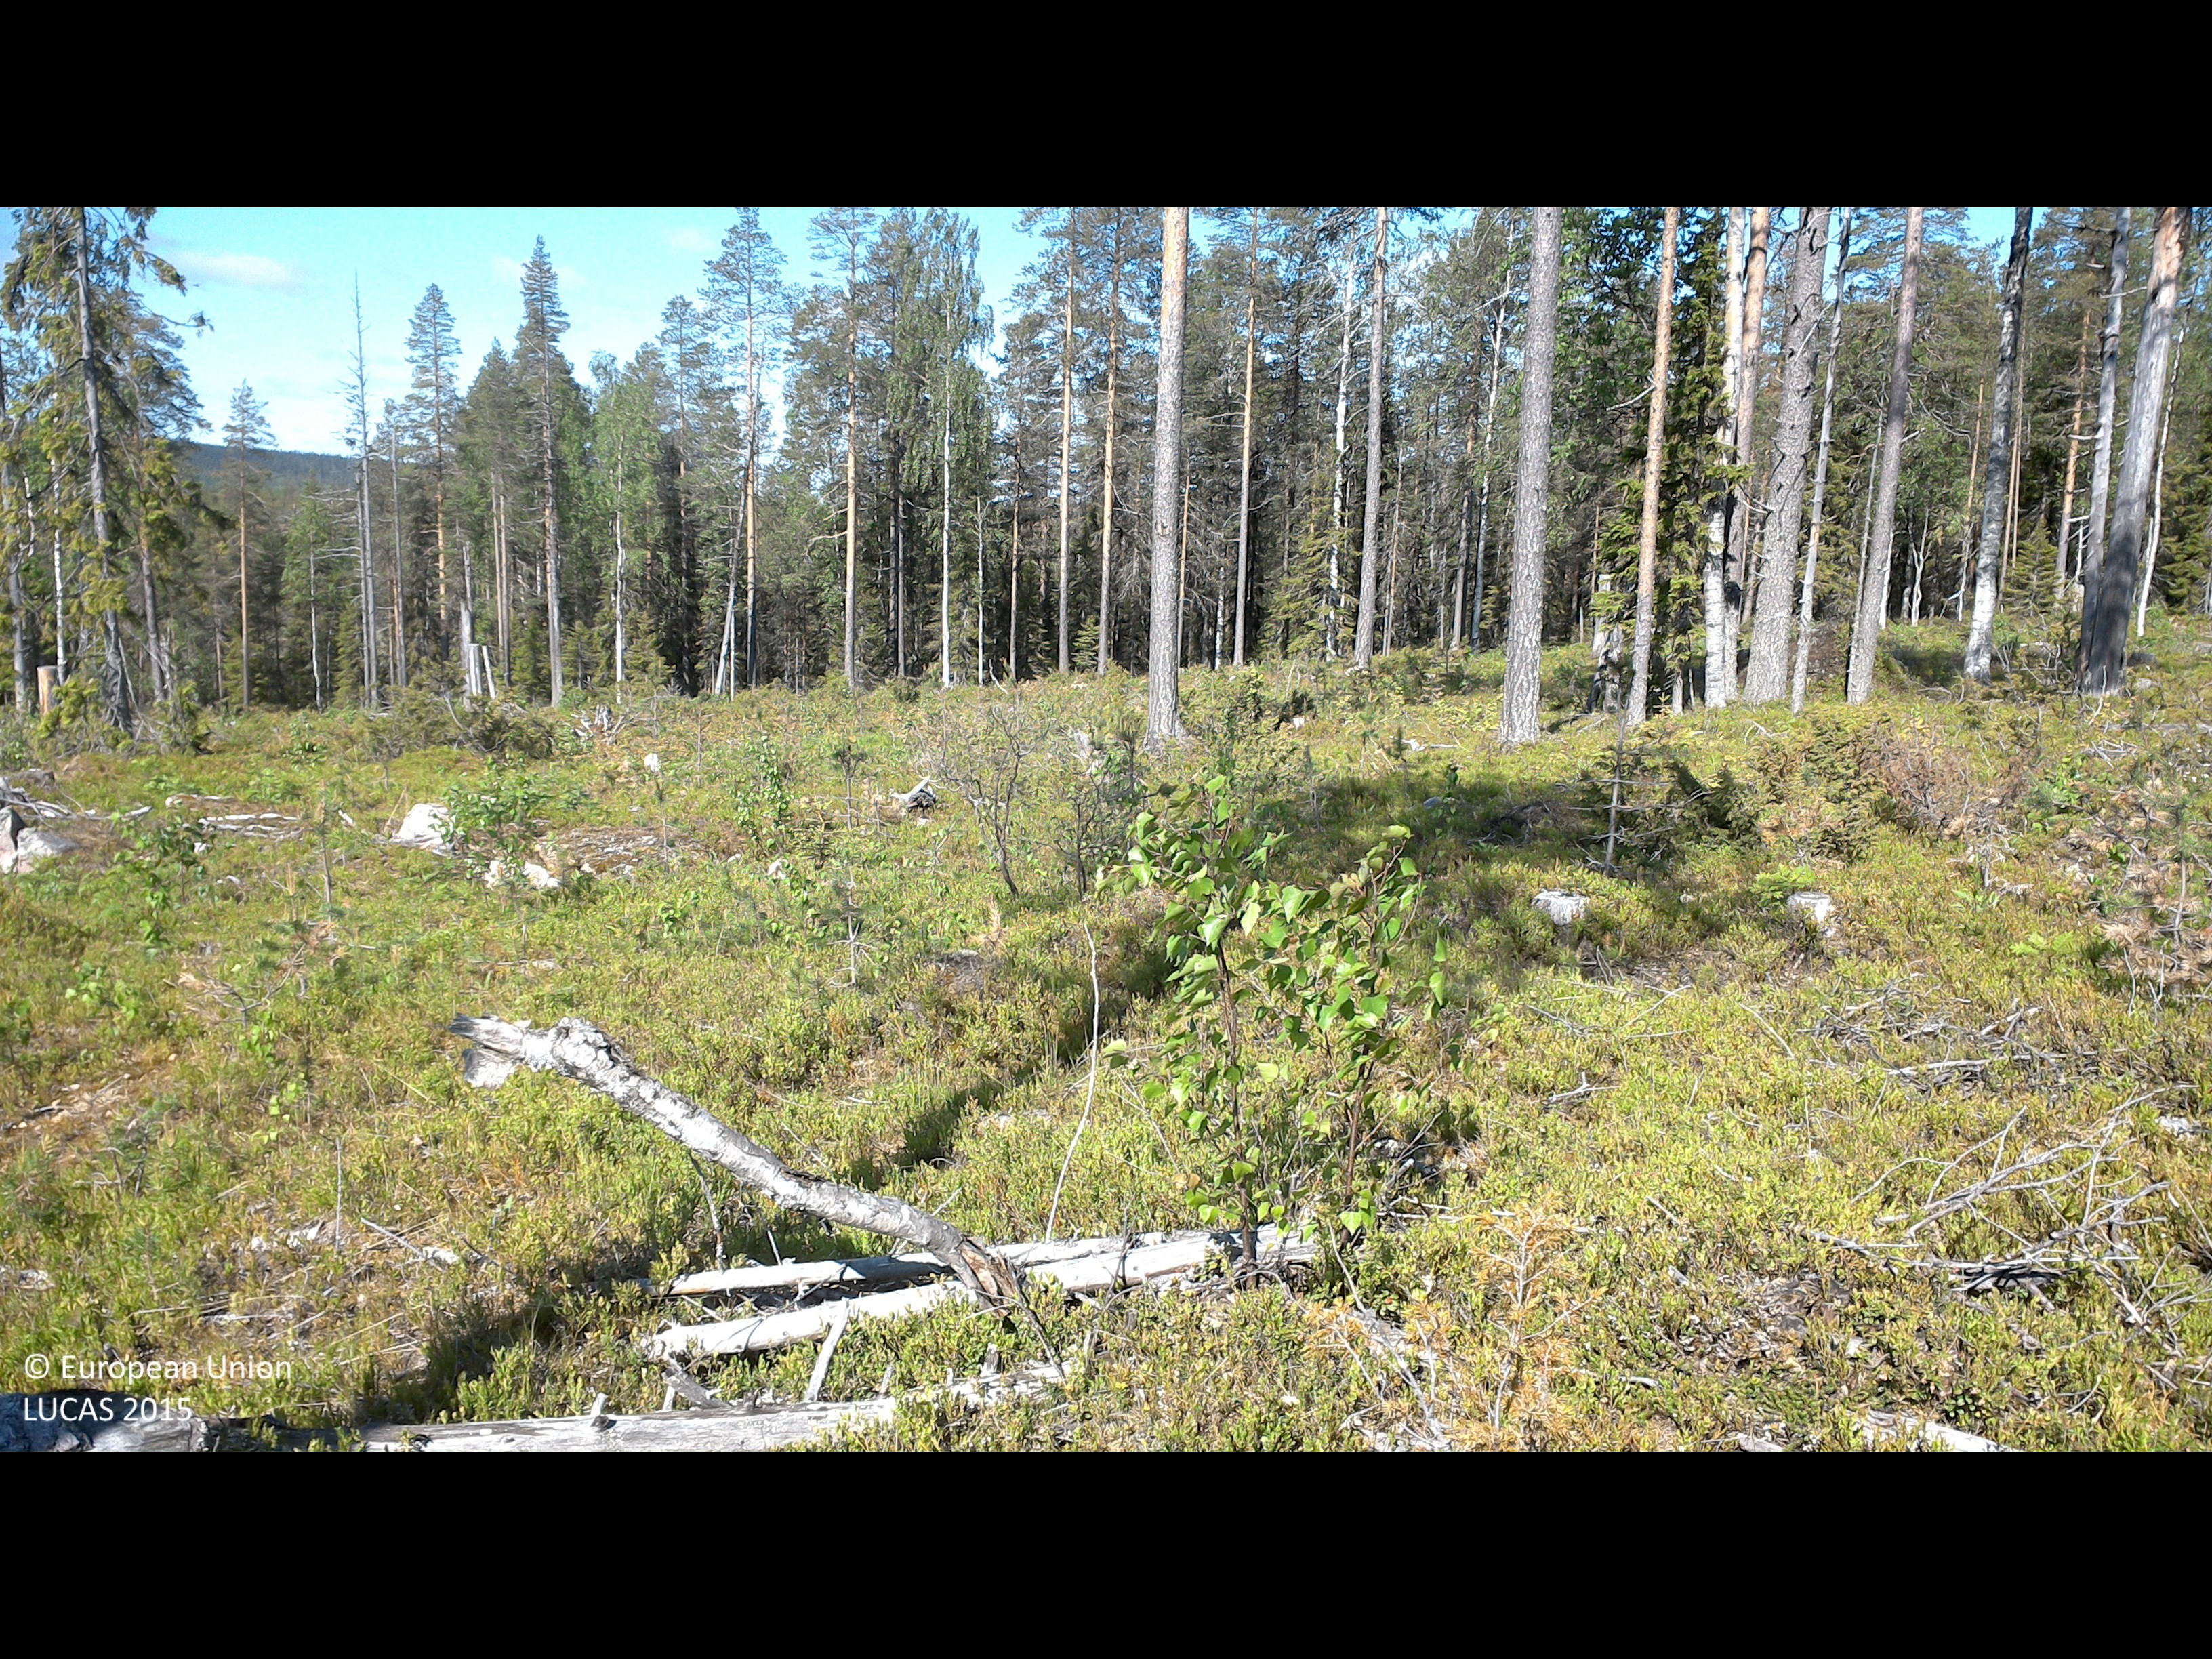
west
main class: Woodland
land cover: Broadleaved woodland
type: boreal forest
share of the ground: 10 - 25 %
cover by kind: shrubs 85 %, broadleaved forest trees 10 %, lichens and mosses 5 %
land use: Forestry
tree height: < 5 m
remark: Clear cut
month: June
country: SE
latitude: 66.6860
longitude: 22.5822
